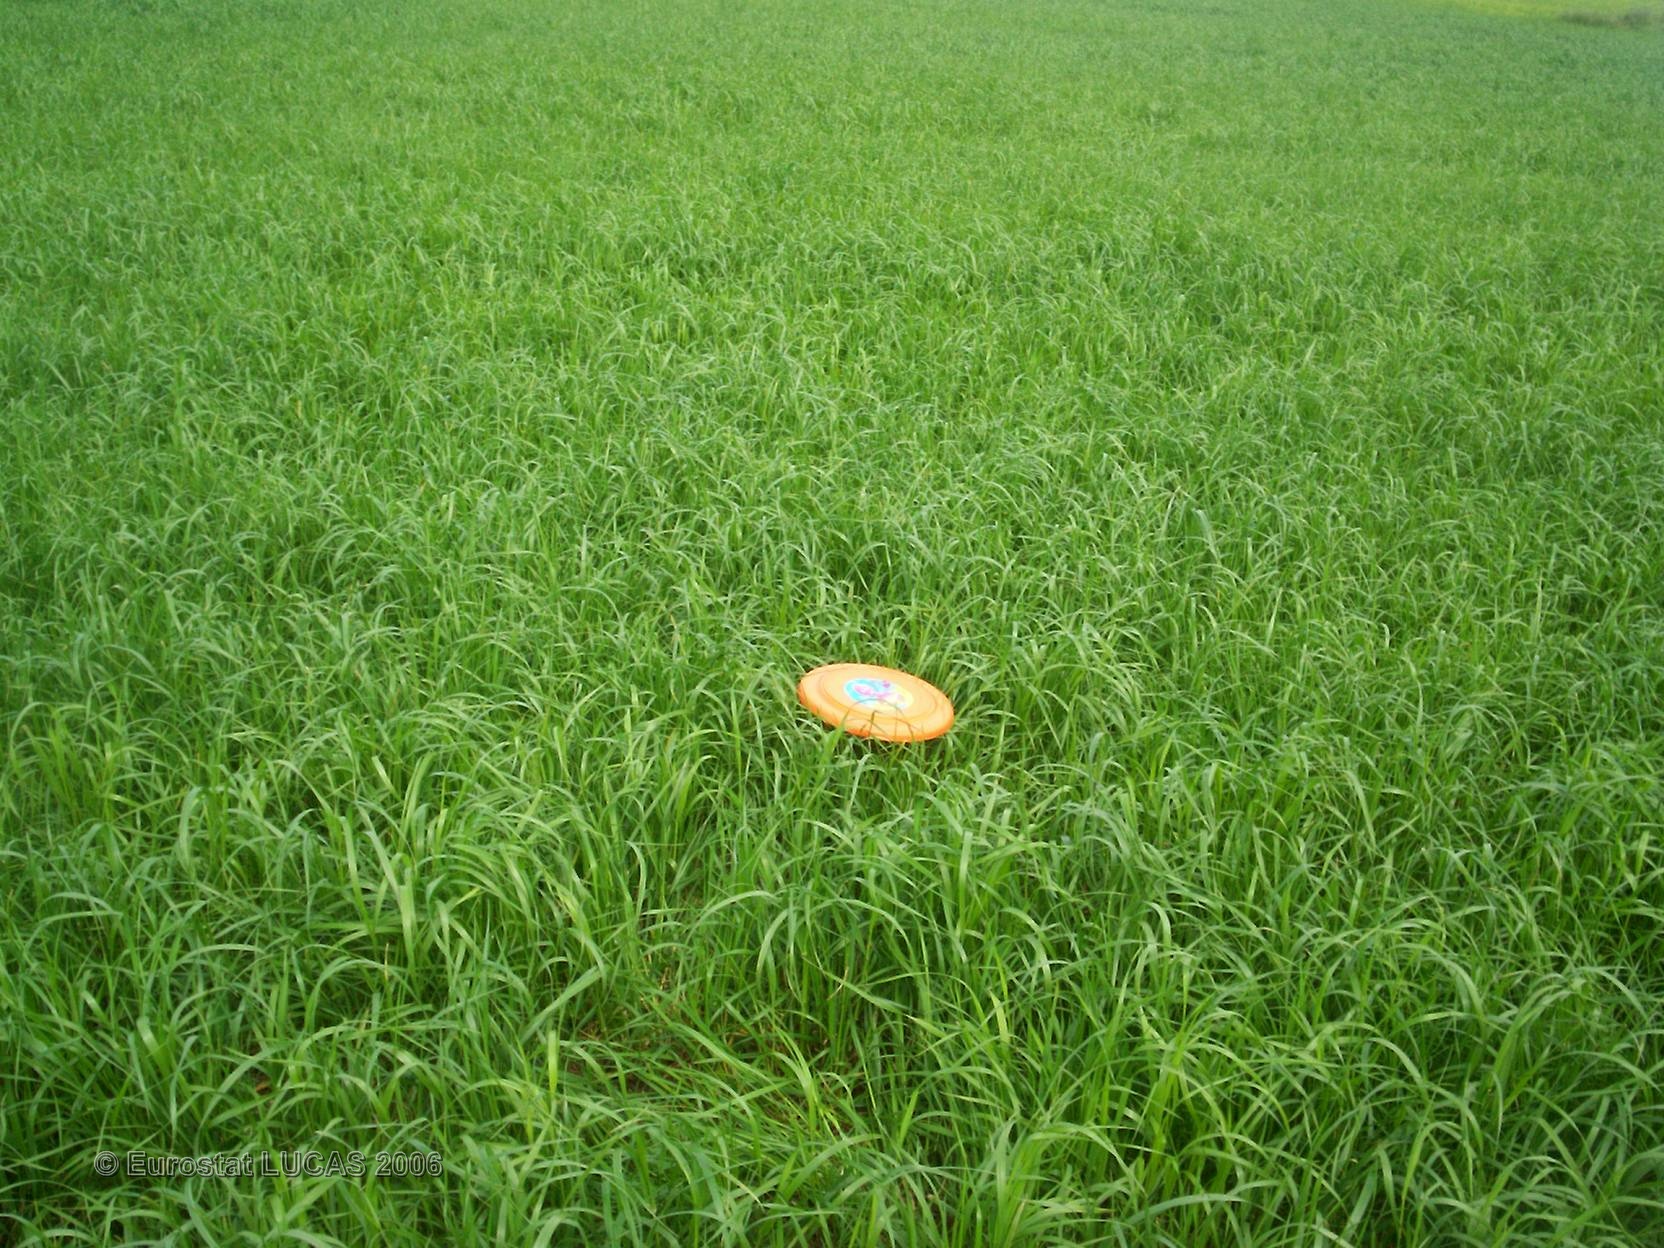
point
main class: Grassland
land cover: Grassland without tree/shrub cover
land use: Agriculture (excluding fallow land and kitchen gardens)
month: May
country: FR
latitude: 45.2663
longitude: 4.7665
